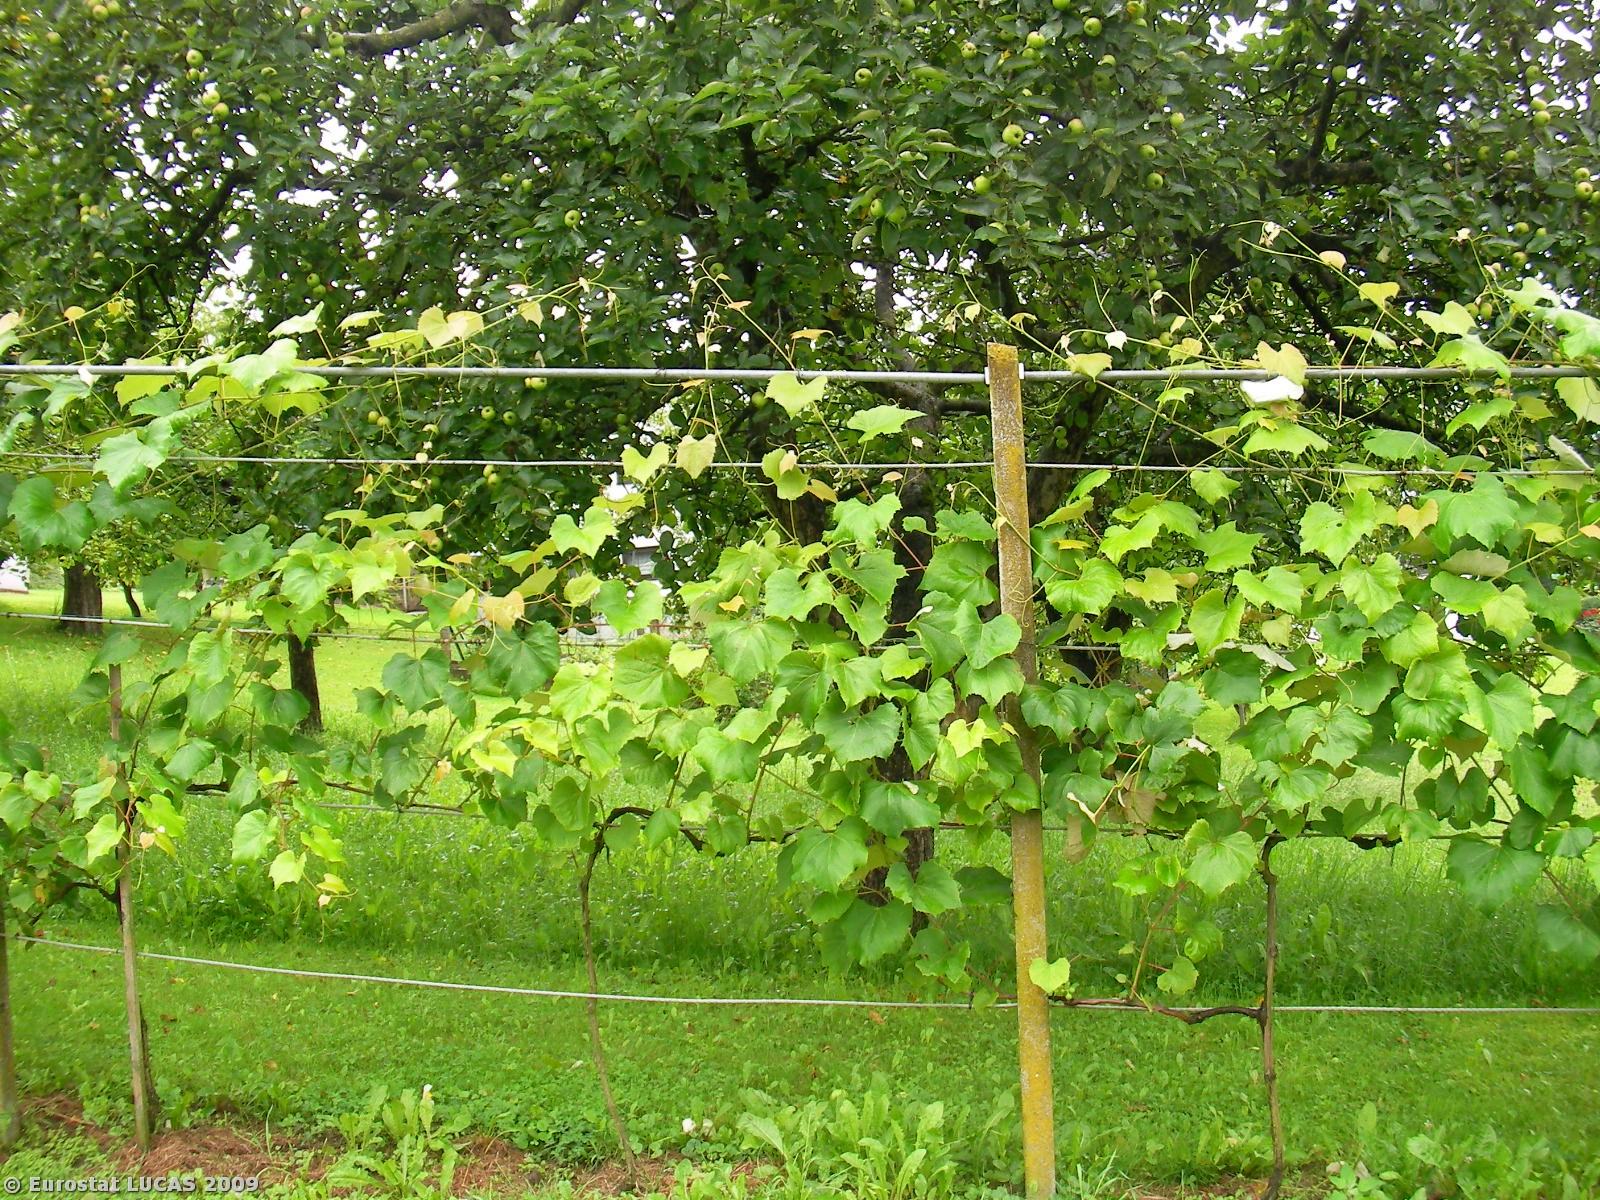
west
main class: Grassland
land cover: Grassland without tree/shrub cover
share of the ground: > 75 %
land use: Agriculture (excluding fallow land and kitchen gardens)
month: July
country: AT
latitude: 46.9027
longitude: 15.7105
